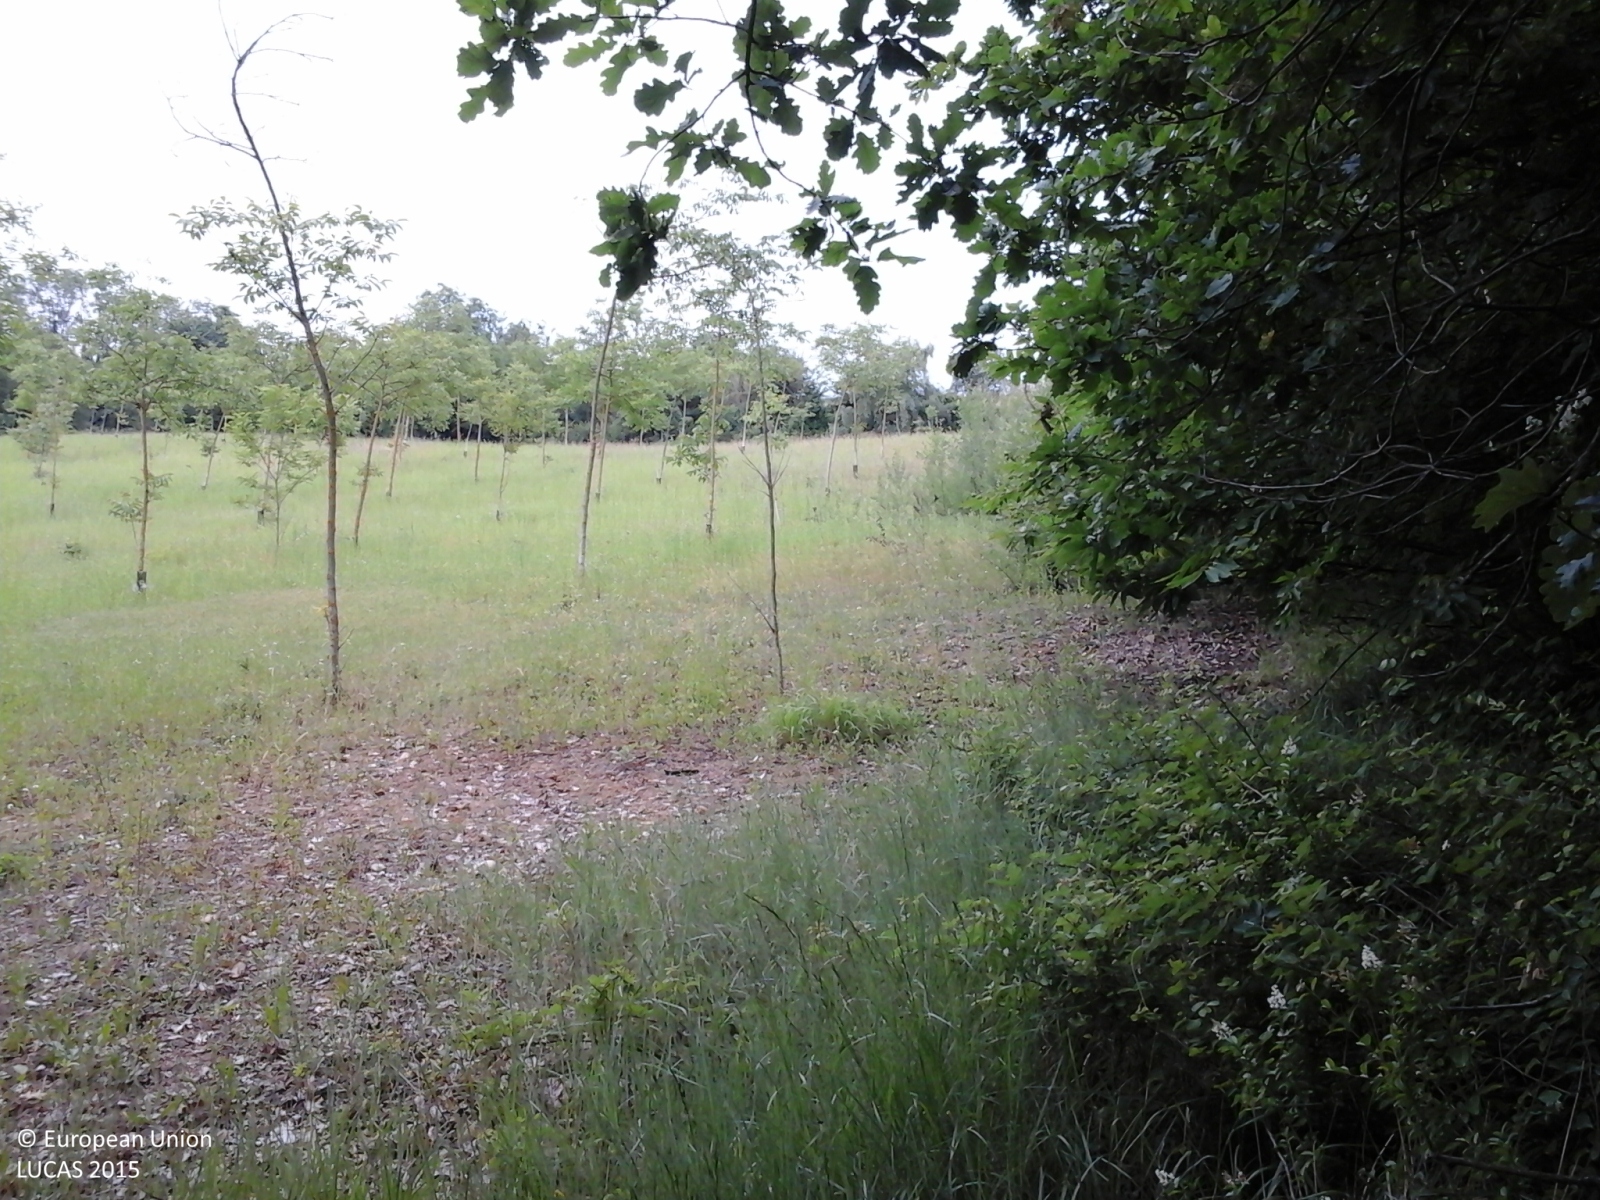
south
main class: Woodland
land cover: Broadleaved woodland
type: thermophilous deciduous forest
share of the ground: > 75 %
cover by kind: broadleaved forest trees 90 %, shrubs 10 %
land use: Forestry
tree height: > 5 m
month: May
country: IT
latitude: 44.6810
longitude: 8.4011
